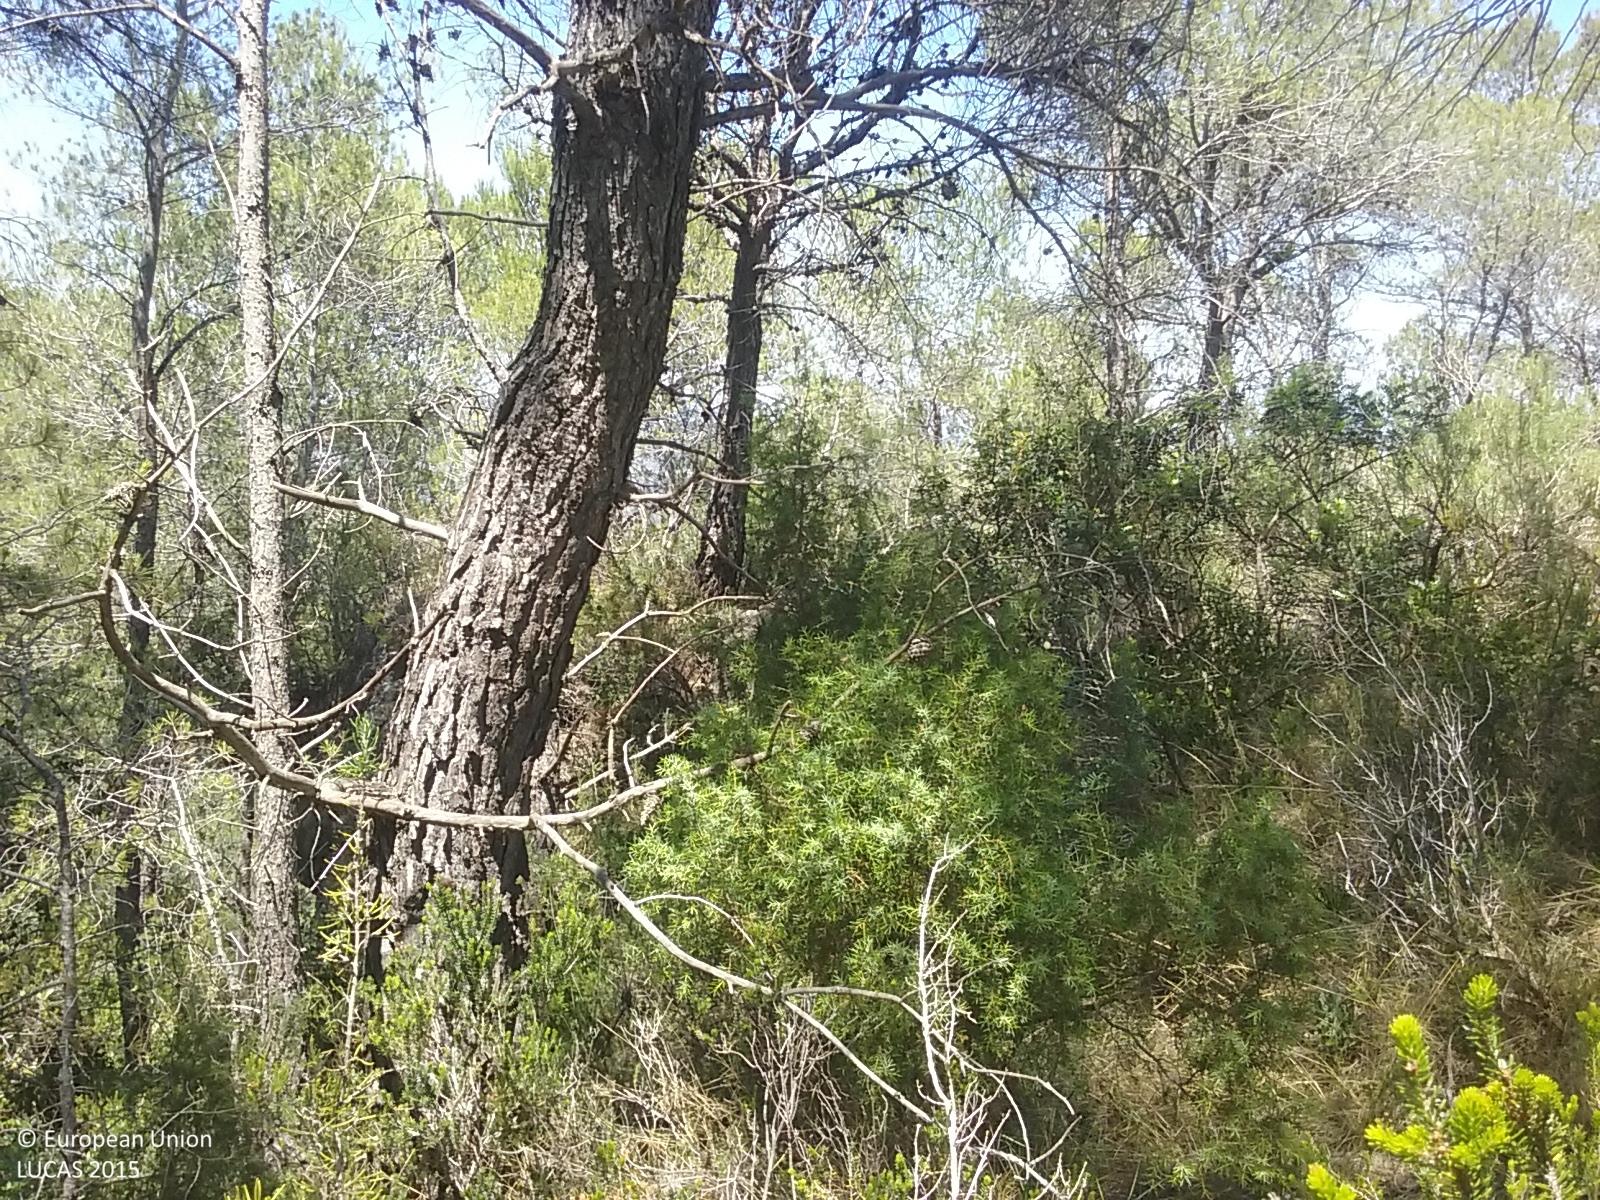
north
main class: Woodland
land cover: Pine dominated coniferous woodland
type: coniferous forest of the mediterranean region
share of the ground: > 75 %
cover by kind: coniferous forest trees 75 %, shrubs 20 %, herbaceous plants 5 %
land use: Semi-natural and natural areas not in use
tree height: > 5 m
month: June
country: ES
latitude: 40.9969
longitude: 0.5892
